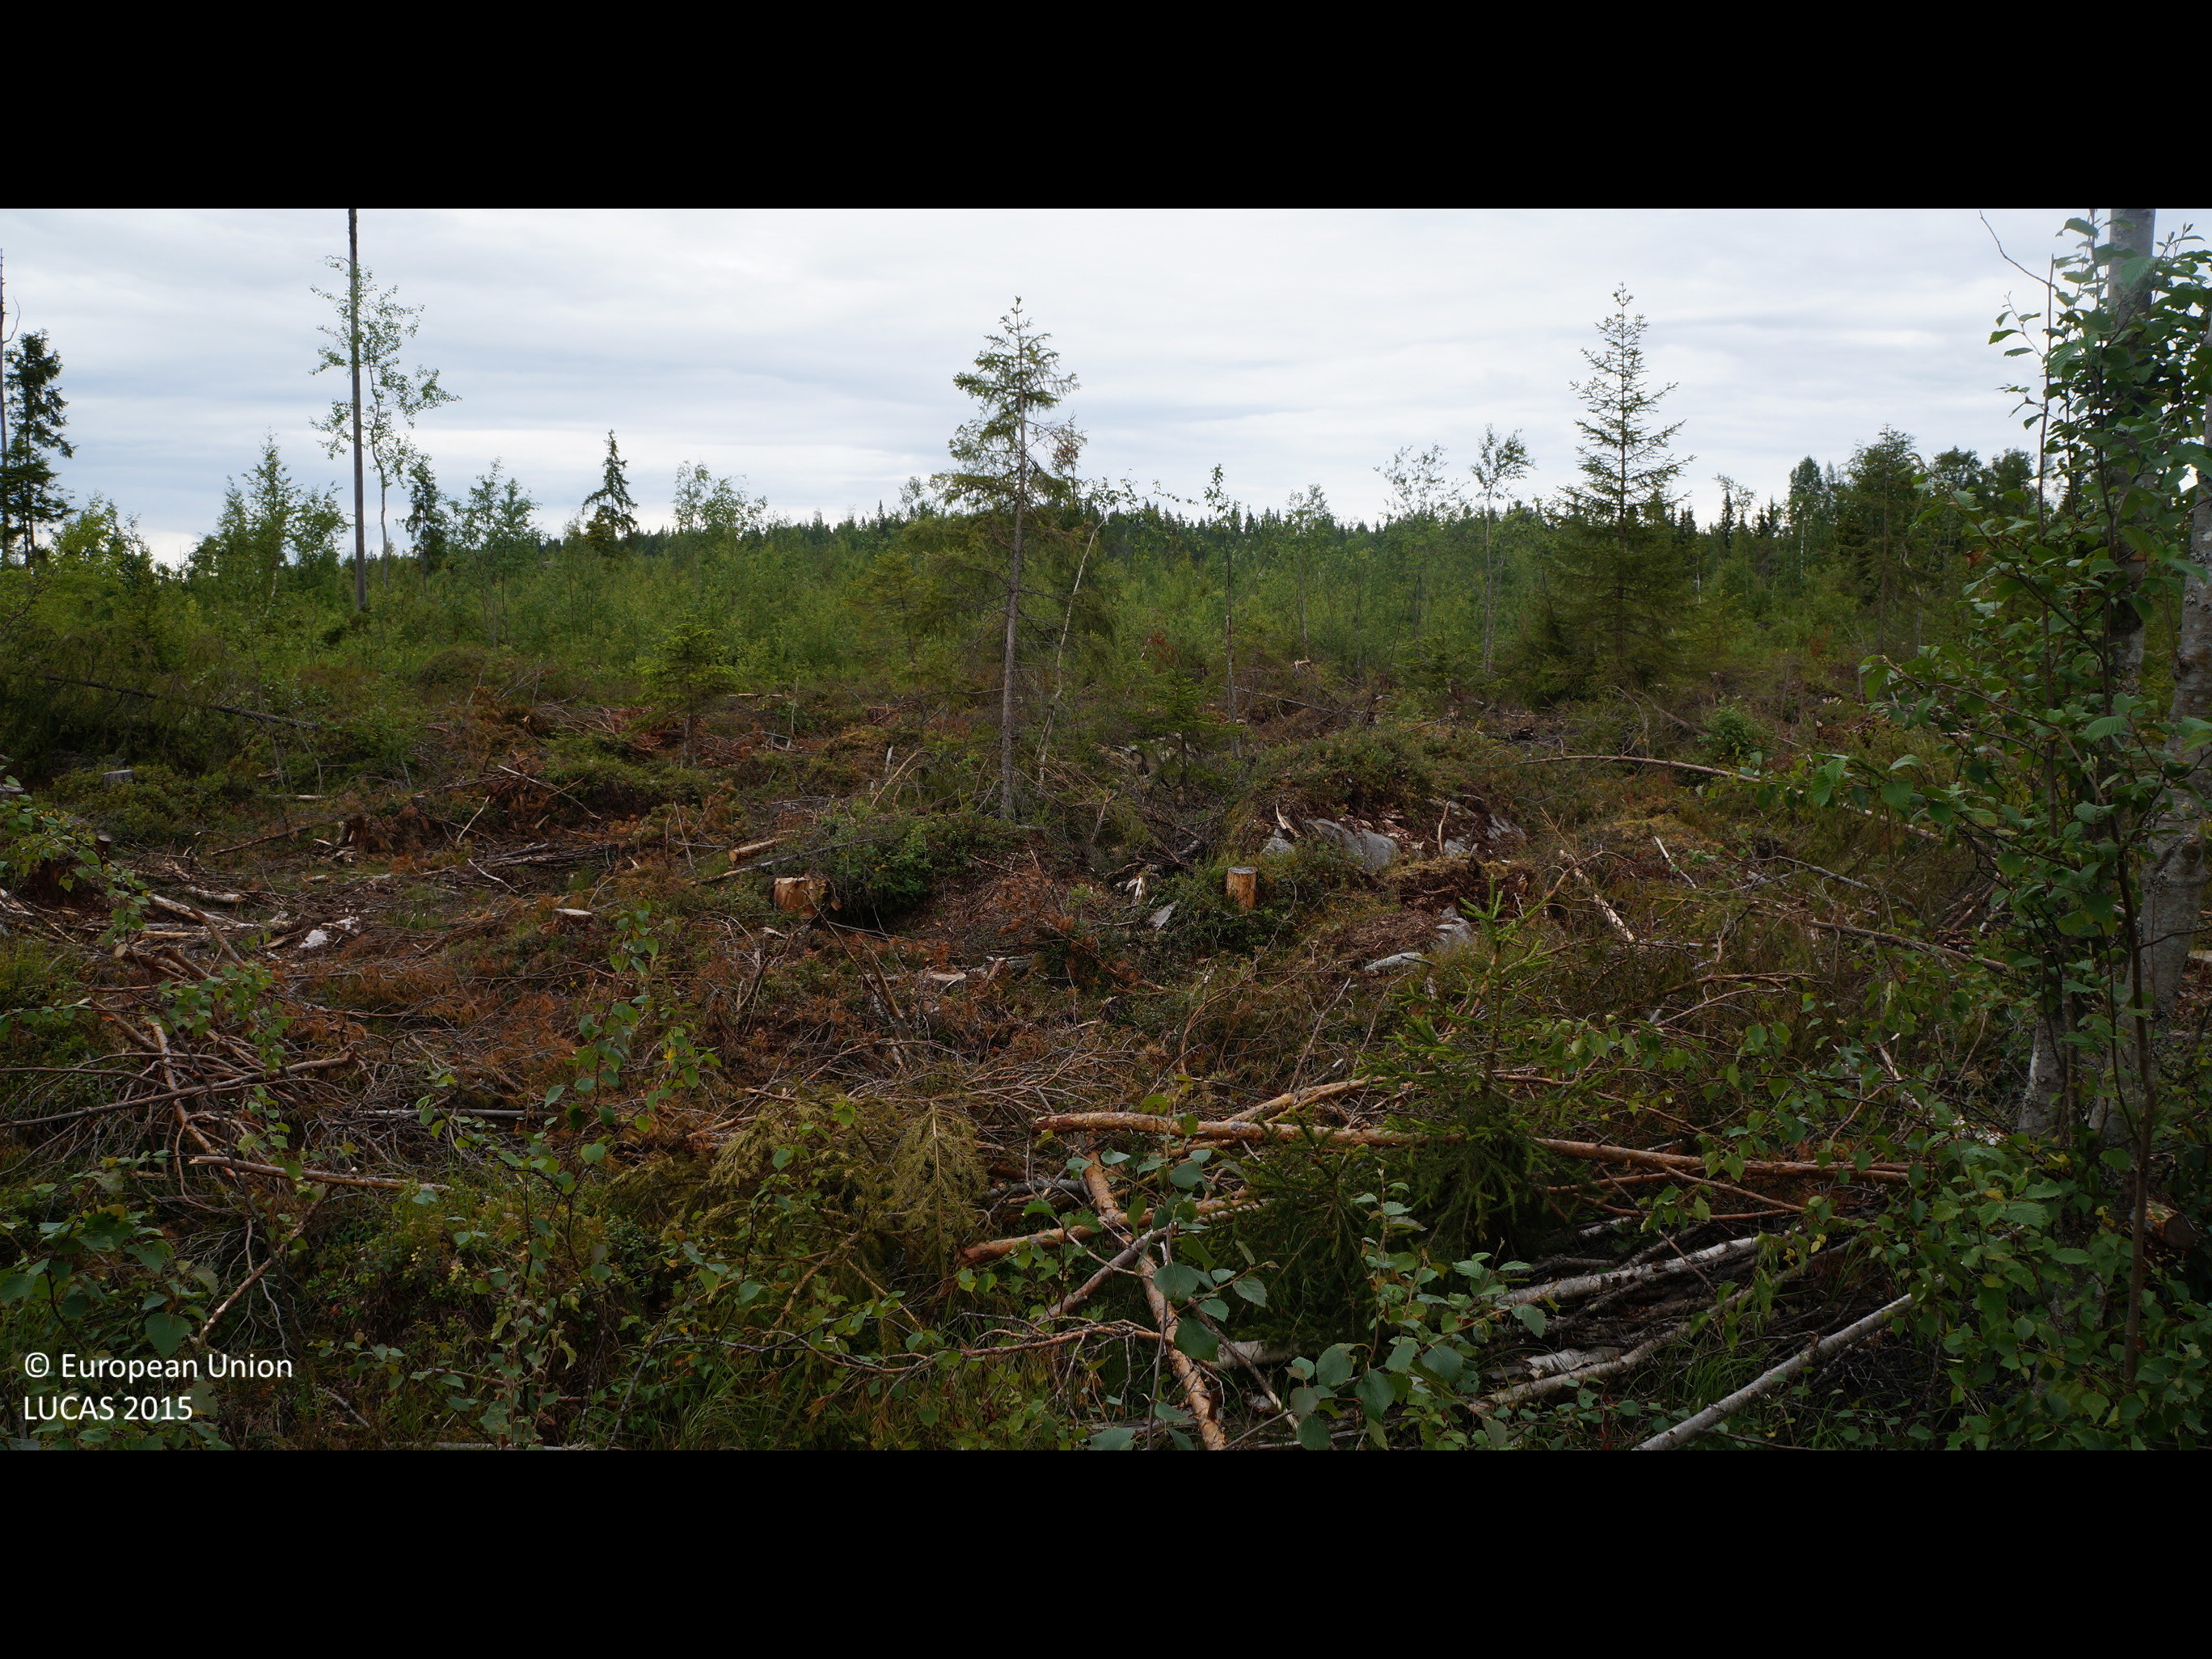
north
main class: Shrubland
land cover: Shrubland with sparse tree cover
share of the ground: > 75 %
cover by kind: shrubs 80 %, broadleaved forest trees 5 %, lichens and mosses 5 %, consolidated bare surface 5 %, unconsolidated bare surface 5 %
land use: Forestry
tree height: > 5 m
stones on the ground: 10 - 25 %
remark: Clear cut
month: July
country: FI
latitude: 64.0222
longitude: 24.5002
